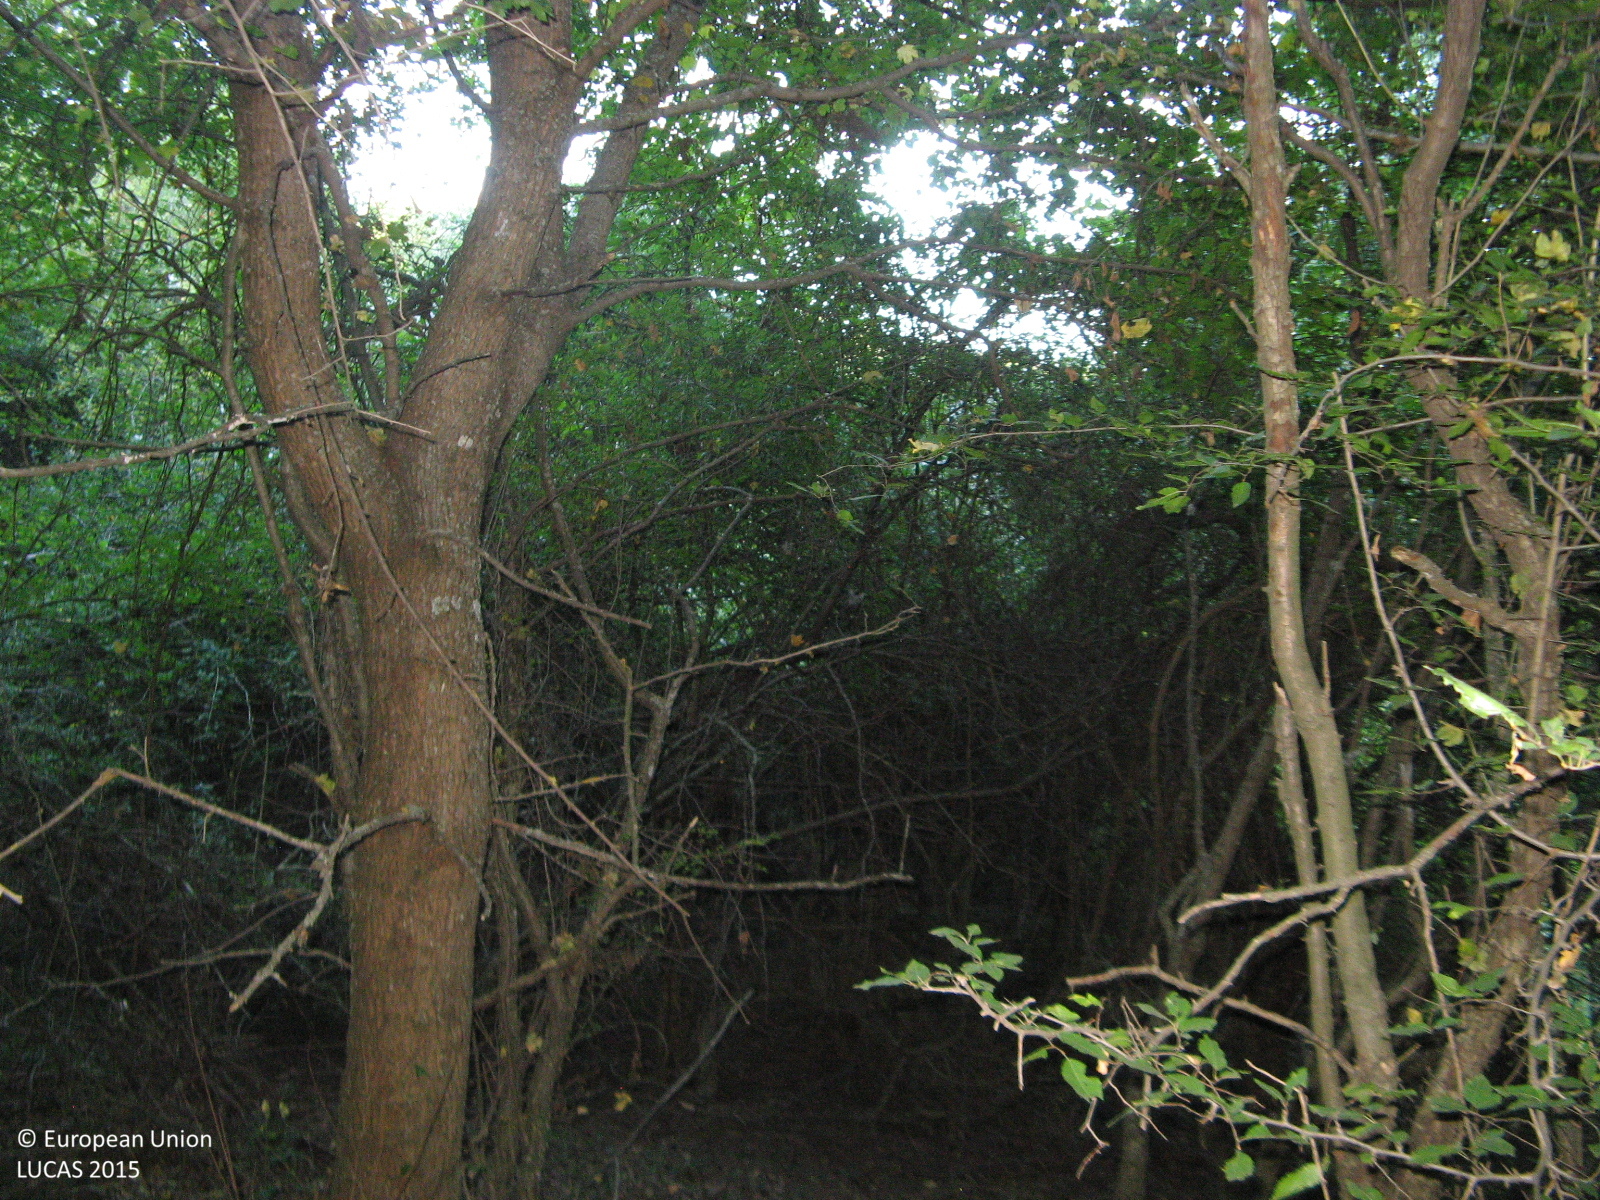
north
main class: Woodland
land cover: Broadleaved woodland
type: thermophilous deciduous forest
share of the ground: > 75 %
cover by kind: broadleaved forest trees 95 %, shrubs 5 %
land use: Forestry
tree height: > 5 m
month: September
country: BG
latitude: 43.5467
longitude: 26.0737
